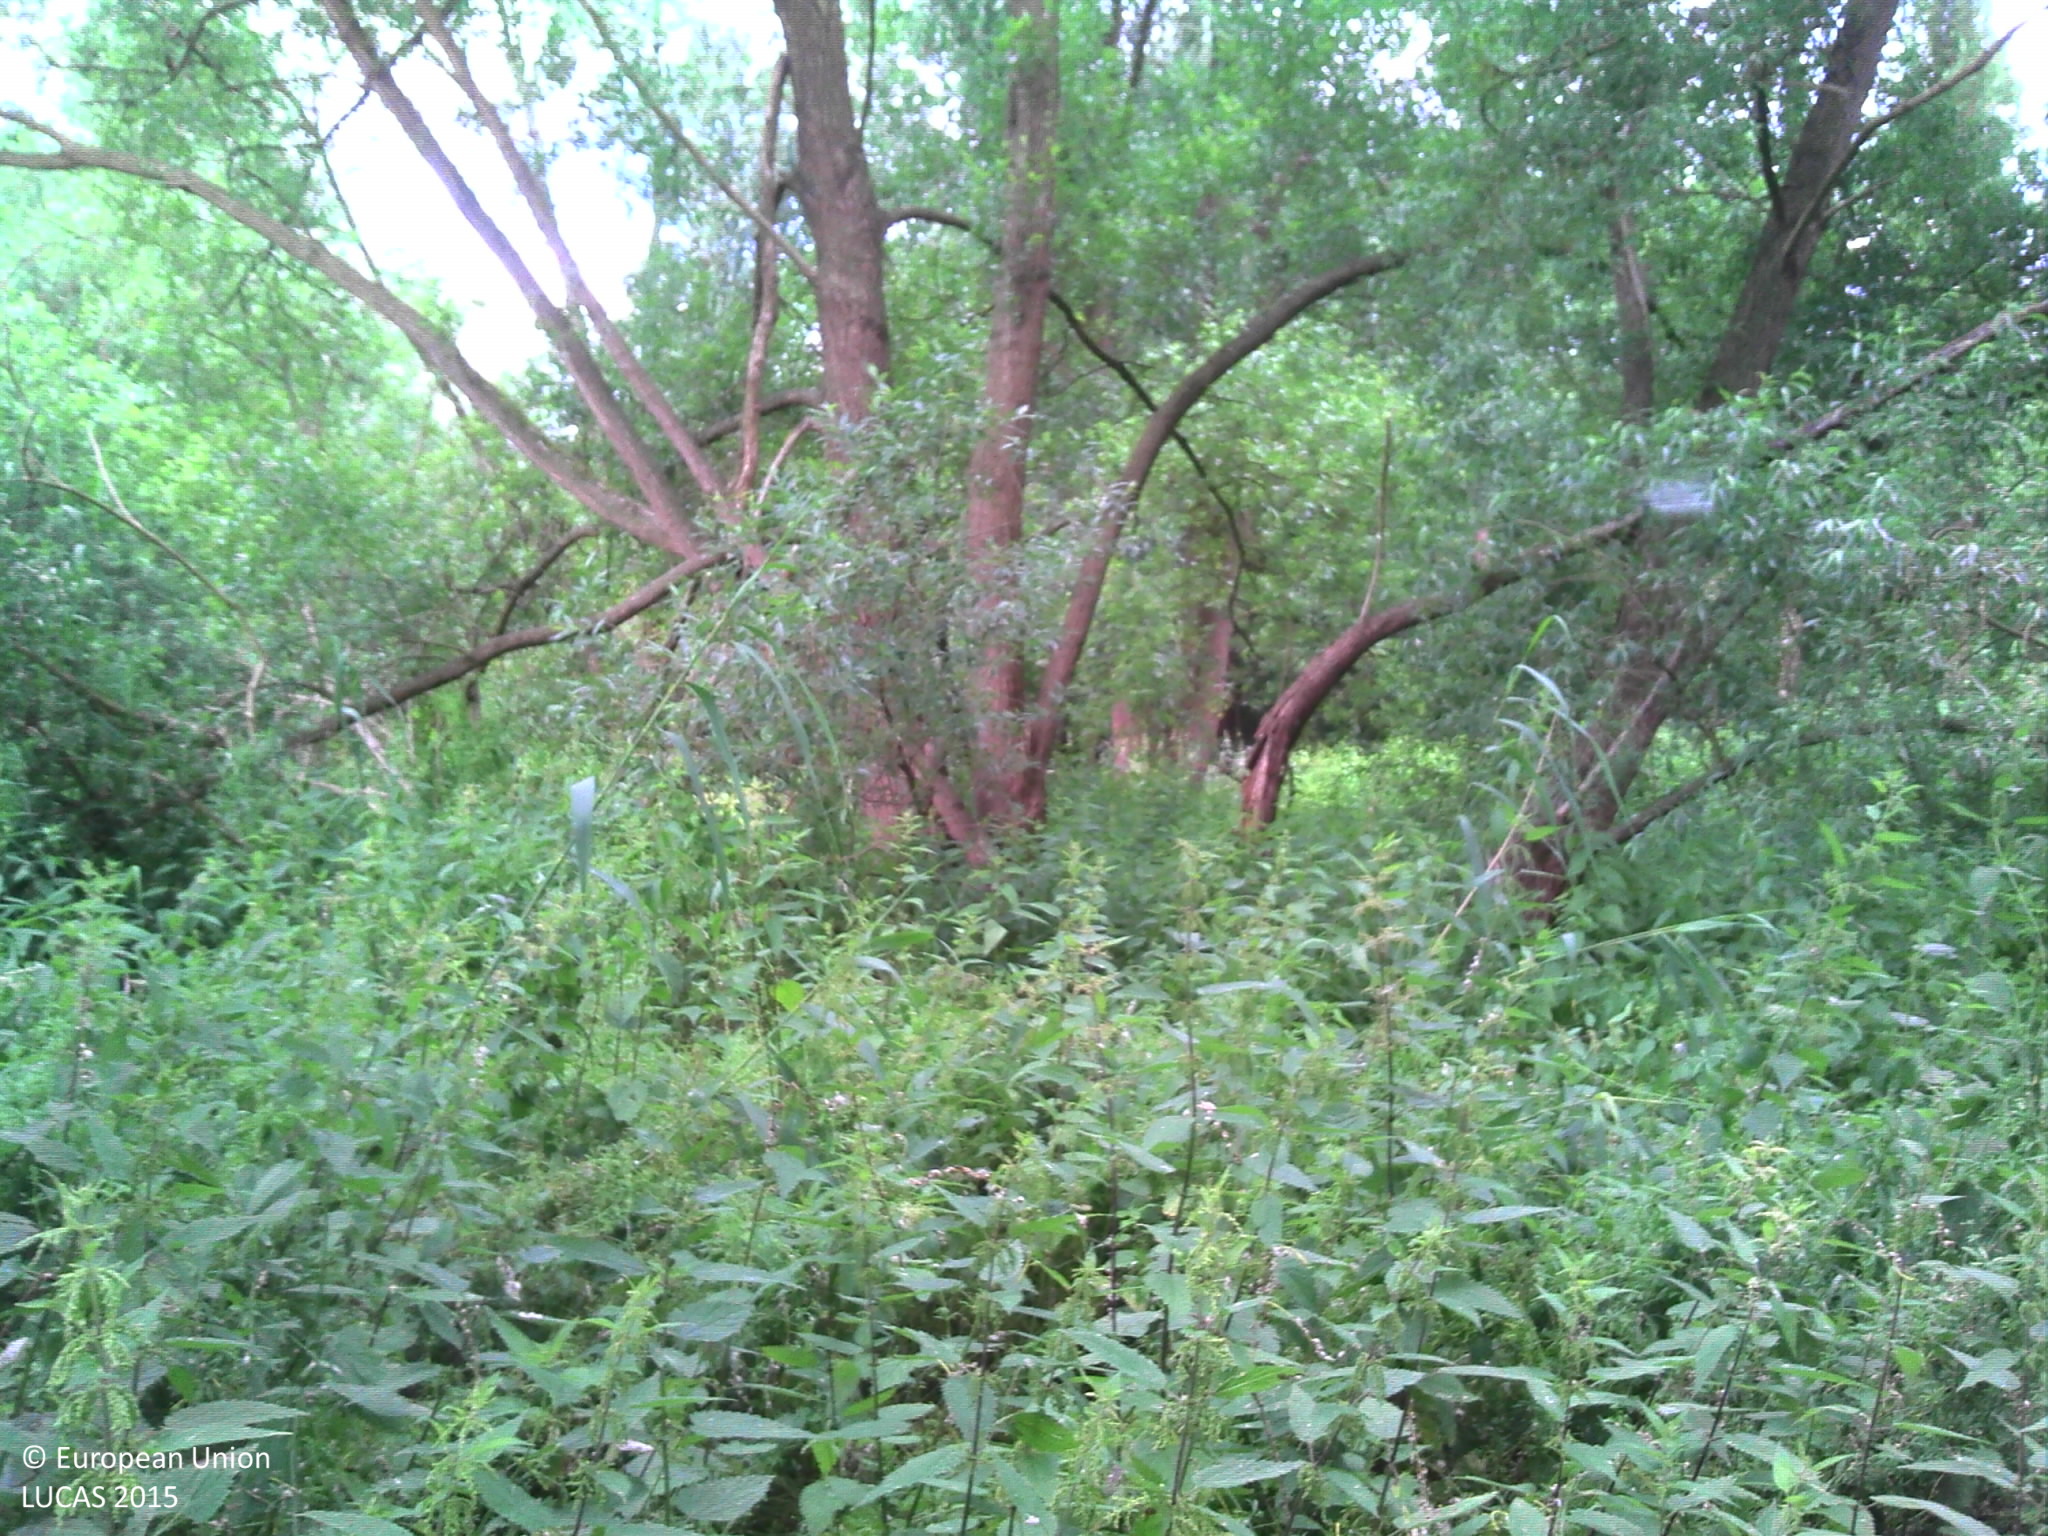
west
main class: Woodland
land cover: Broadleaved woodland
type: floodplain forest
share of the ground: > 75 %
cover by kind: broadleaved forest trees 100 %
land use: Forestry
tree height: > 5 m
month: June
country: BE
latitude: 51.0592
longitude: 3.7581
